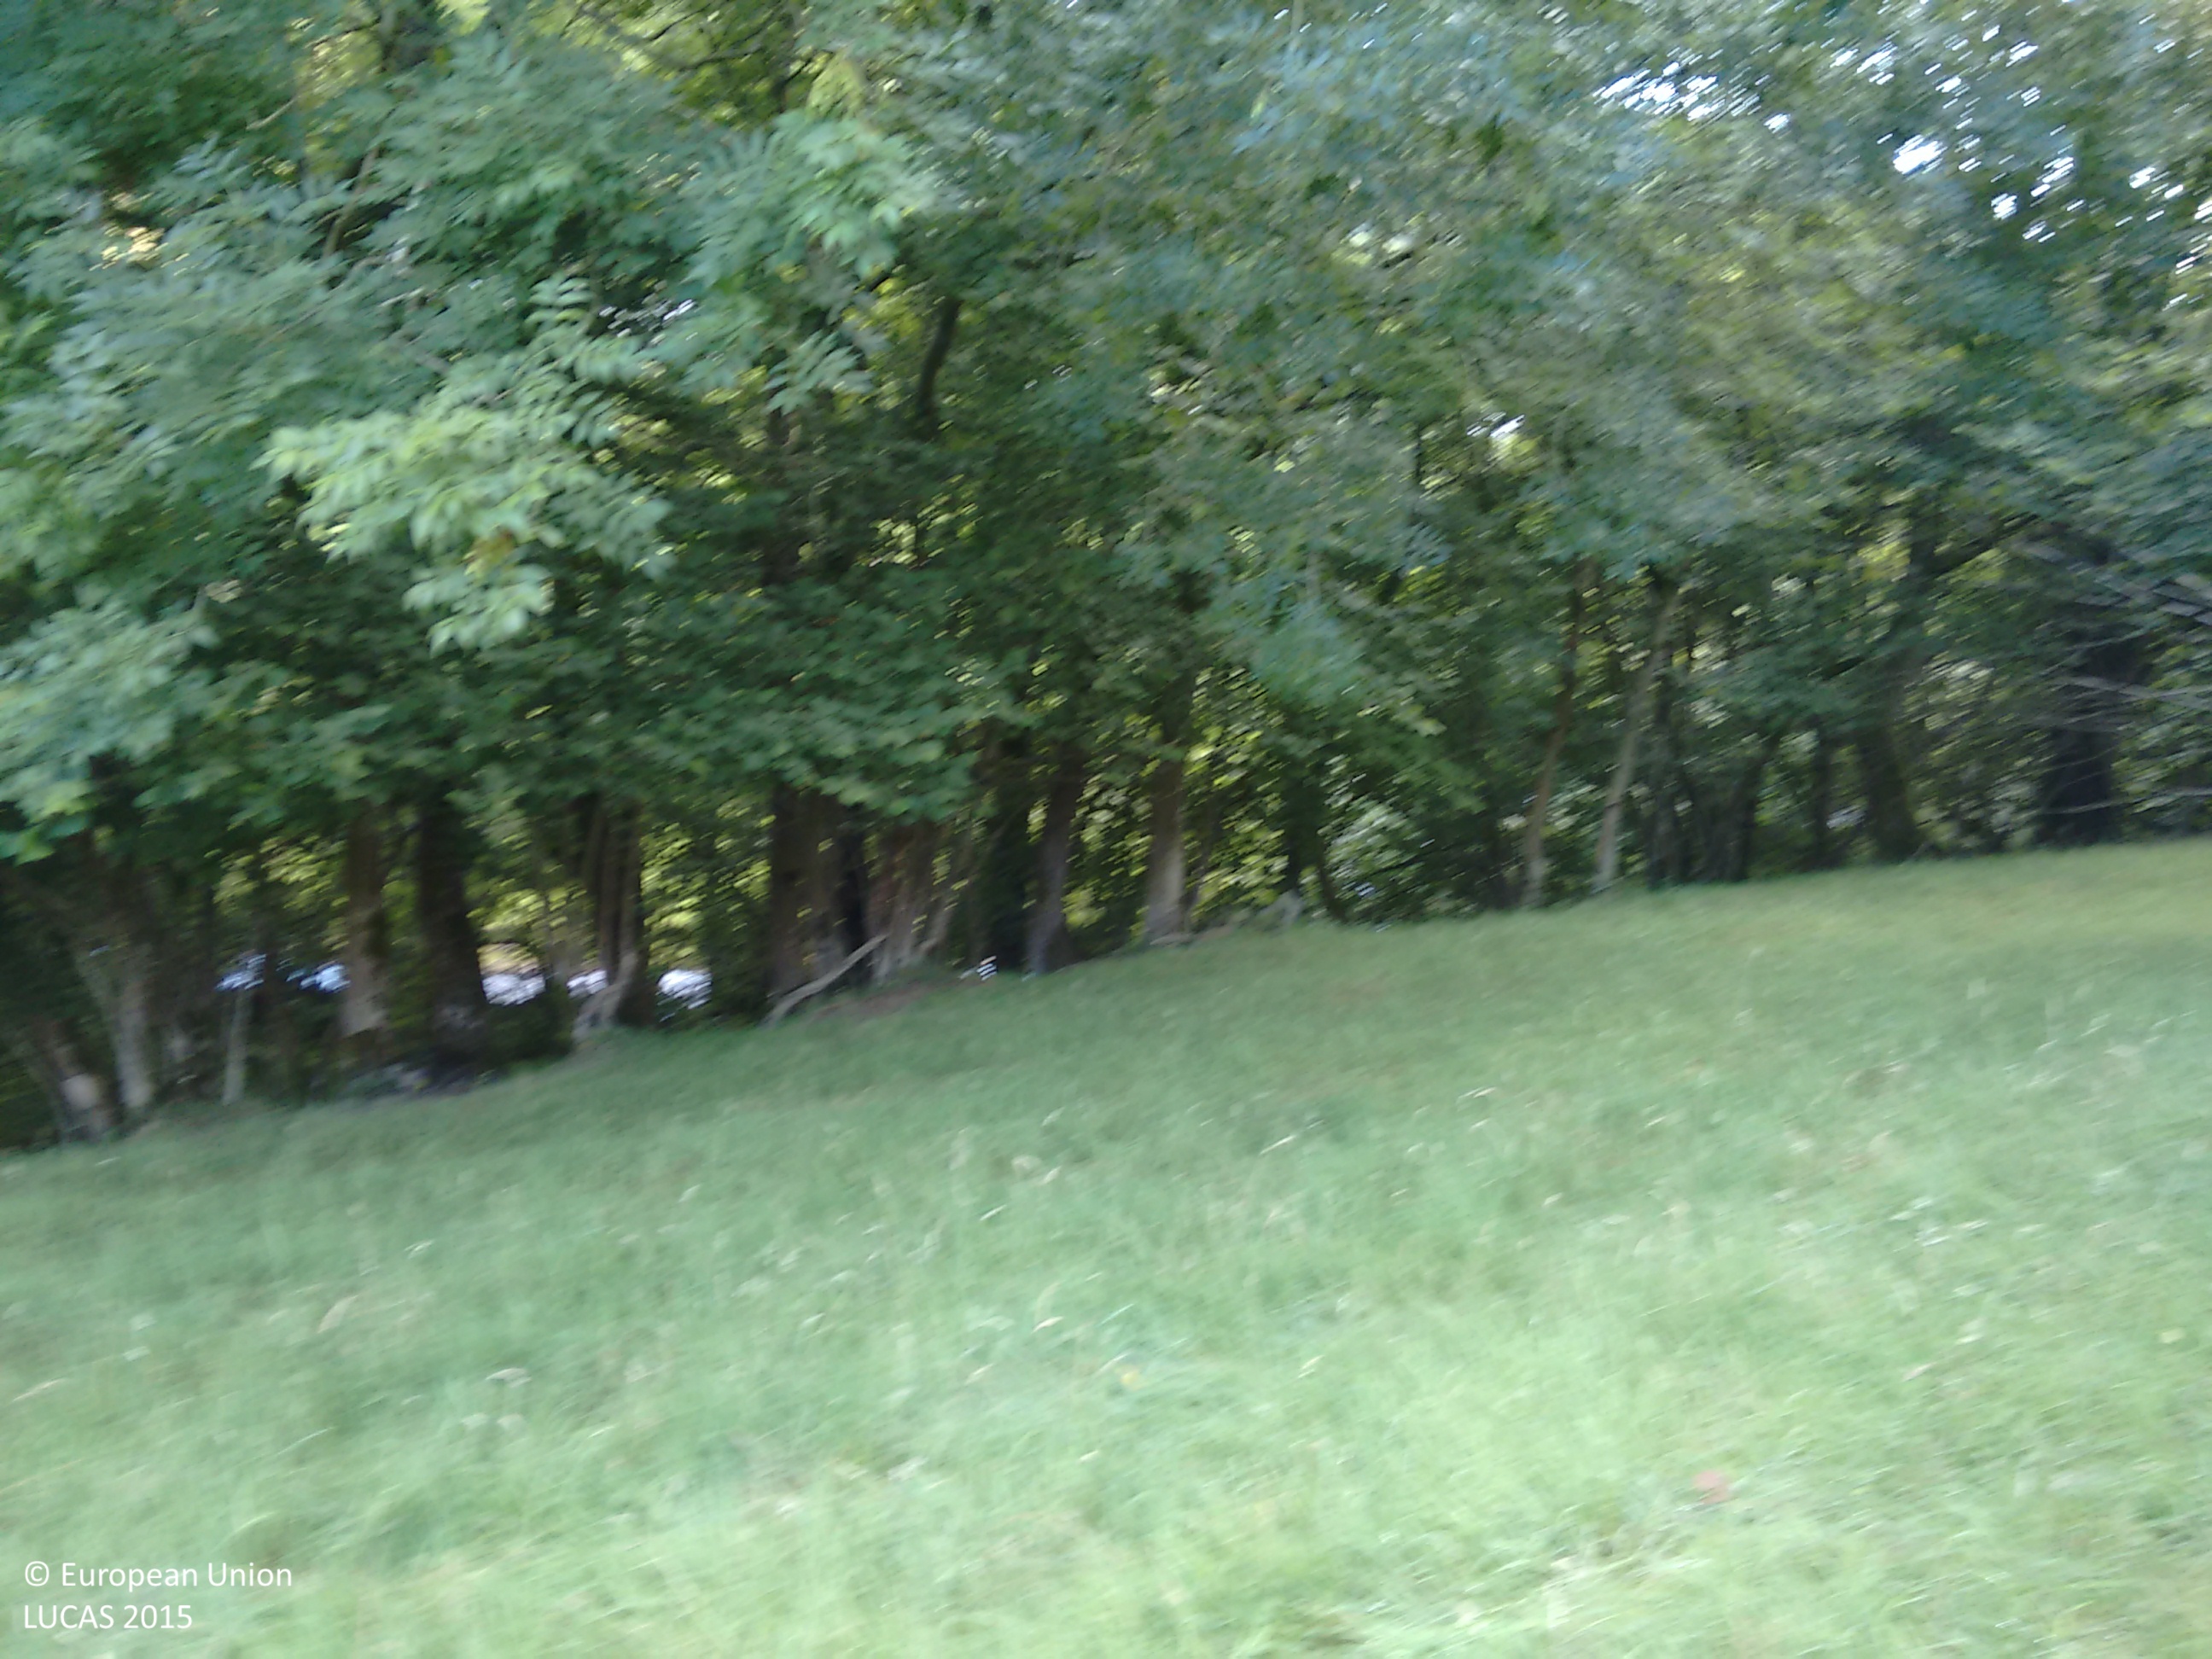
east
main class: Grassland
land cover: Grassland without tree/shrub cover
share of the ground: > 75 %
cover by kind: herbaceous plants 100 %
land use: Agriculture (excluding fallow land and kitchen gardens)
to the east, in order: Grassland without tree/shrub cover; Broadleaved woodland; Rivers and streams; Broadleaved woodland; Grassland without tree/shrub cover; Electric lines; Grassland without tree/shrub cover; Artificial constructions in urban areas; Grassland with sparse tree/shrub cover; Grassland without tree/shrub cover
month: August
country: GB
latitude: 53.1634
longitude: -3.5616
